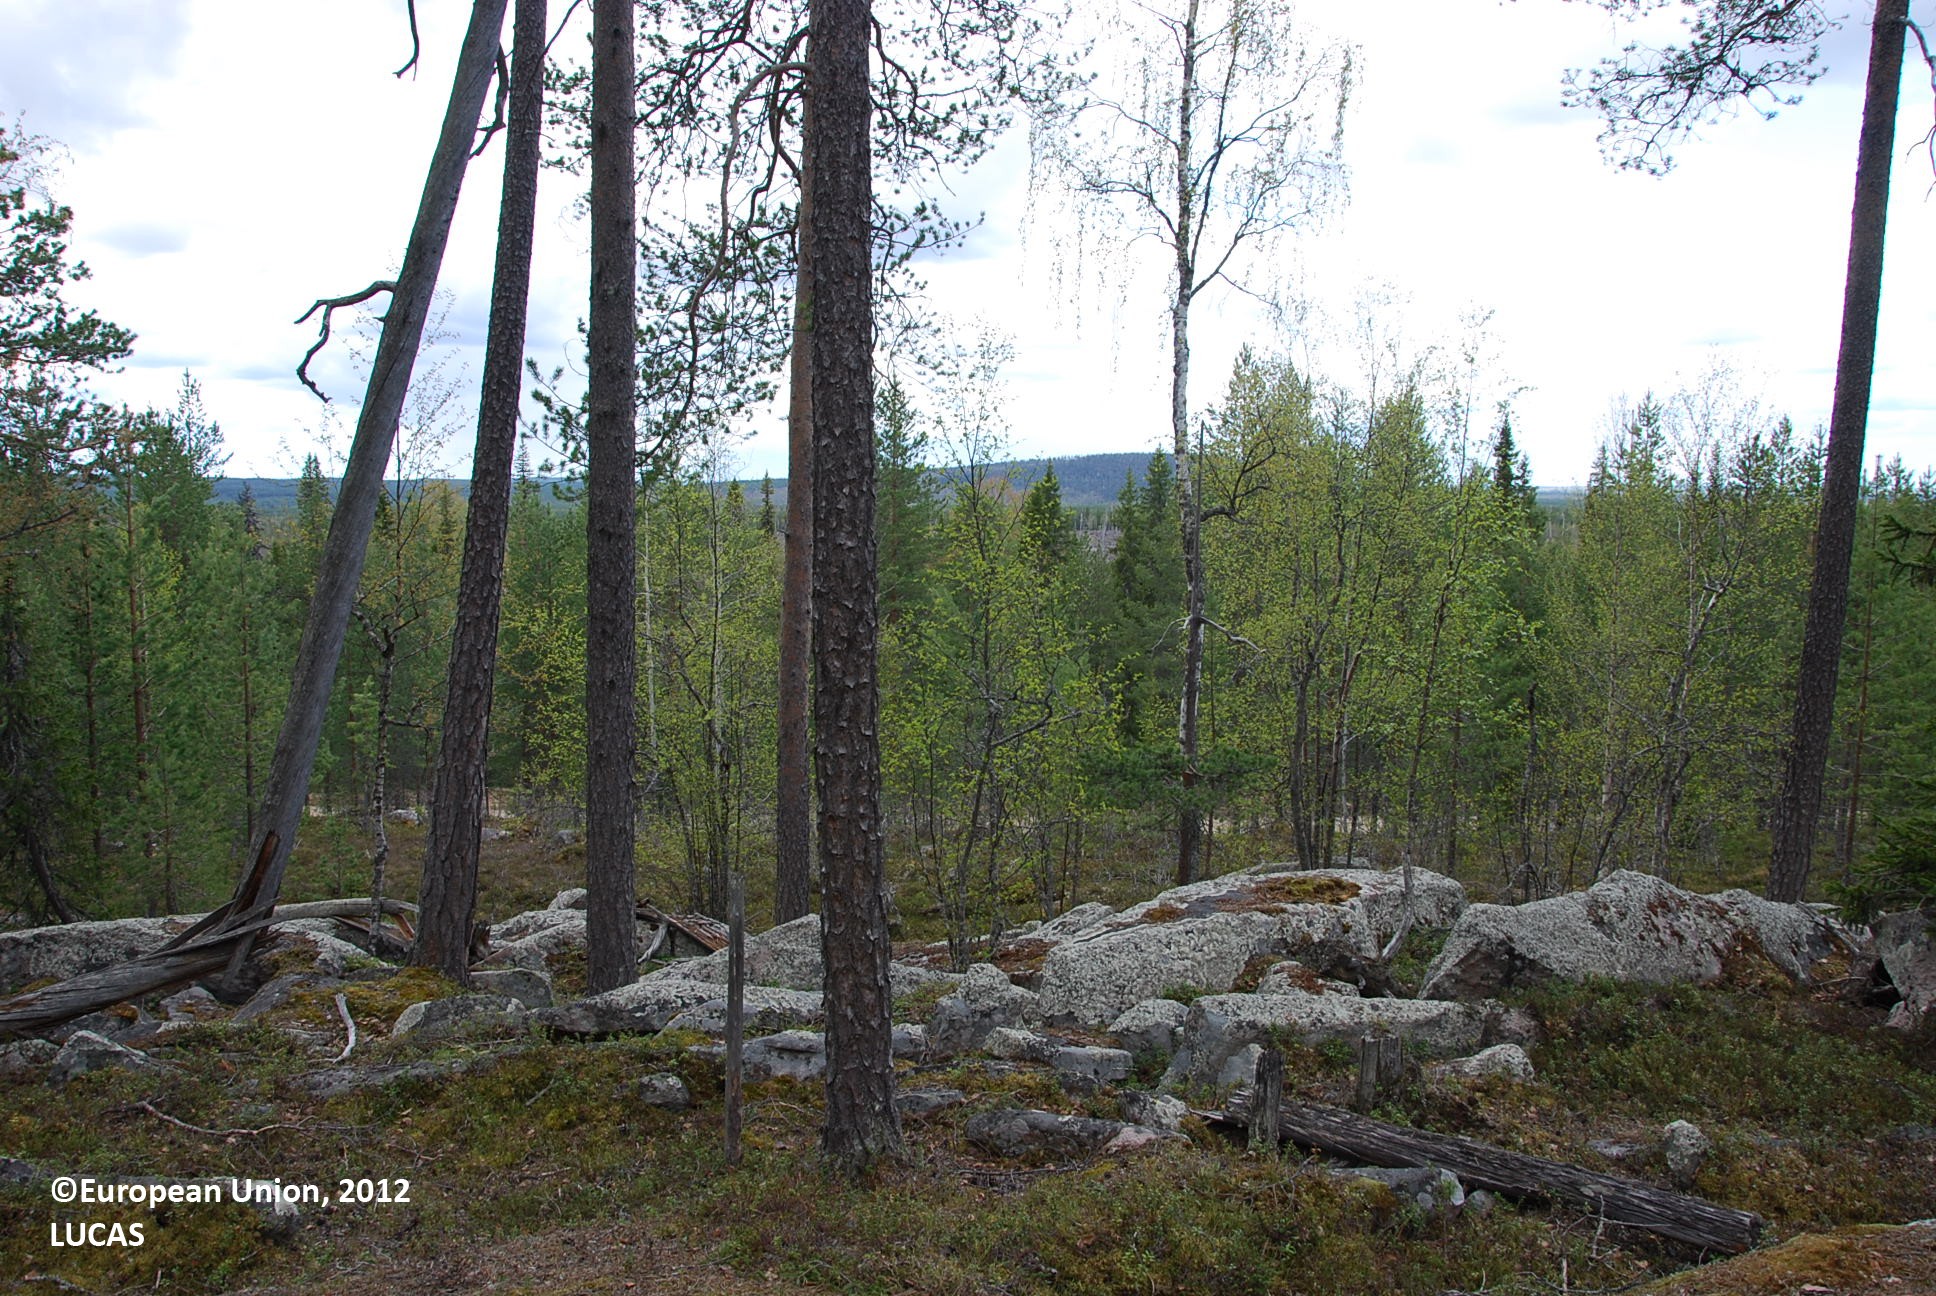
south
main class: Woodland
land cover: Pine dominated coniferous woodland
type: boreal forest
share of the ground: 25 - 50 %
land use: Forestry
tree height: > 5 m
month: May
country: FI
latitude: 66.8914
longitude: 28.2842
